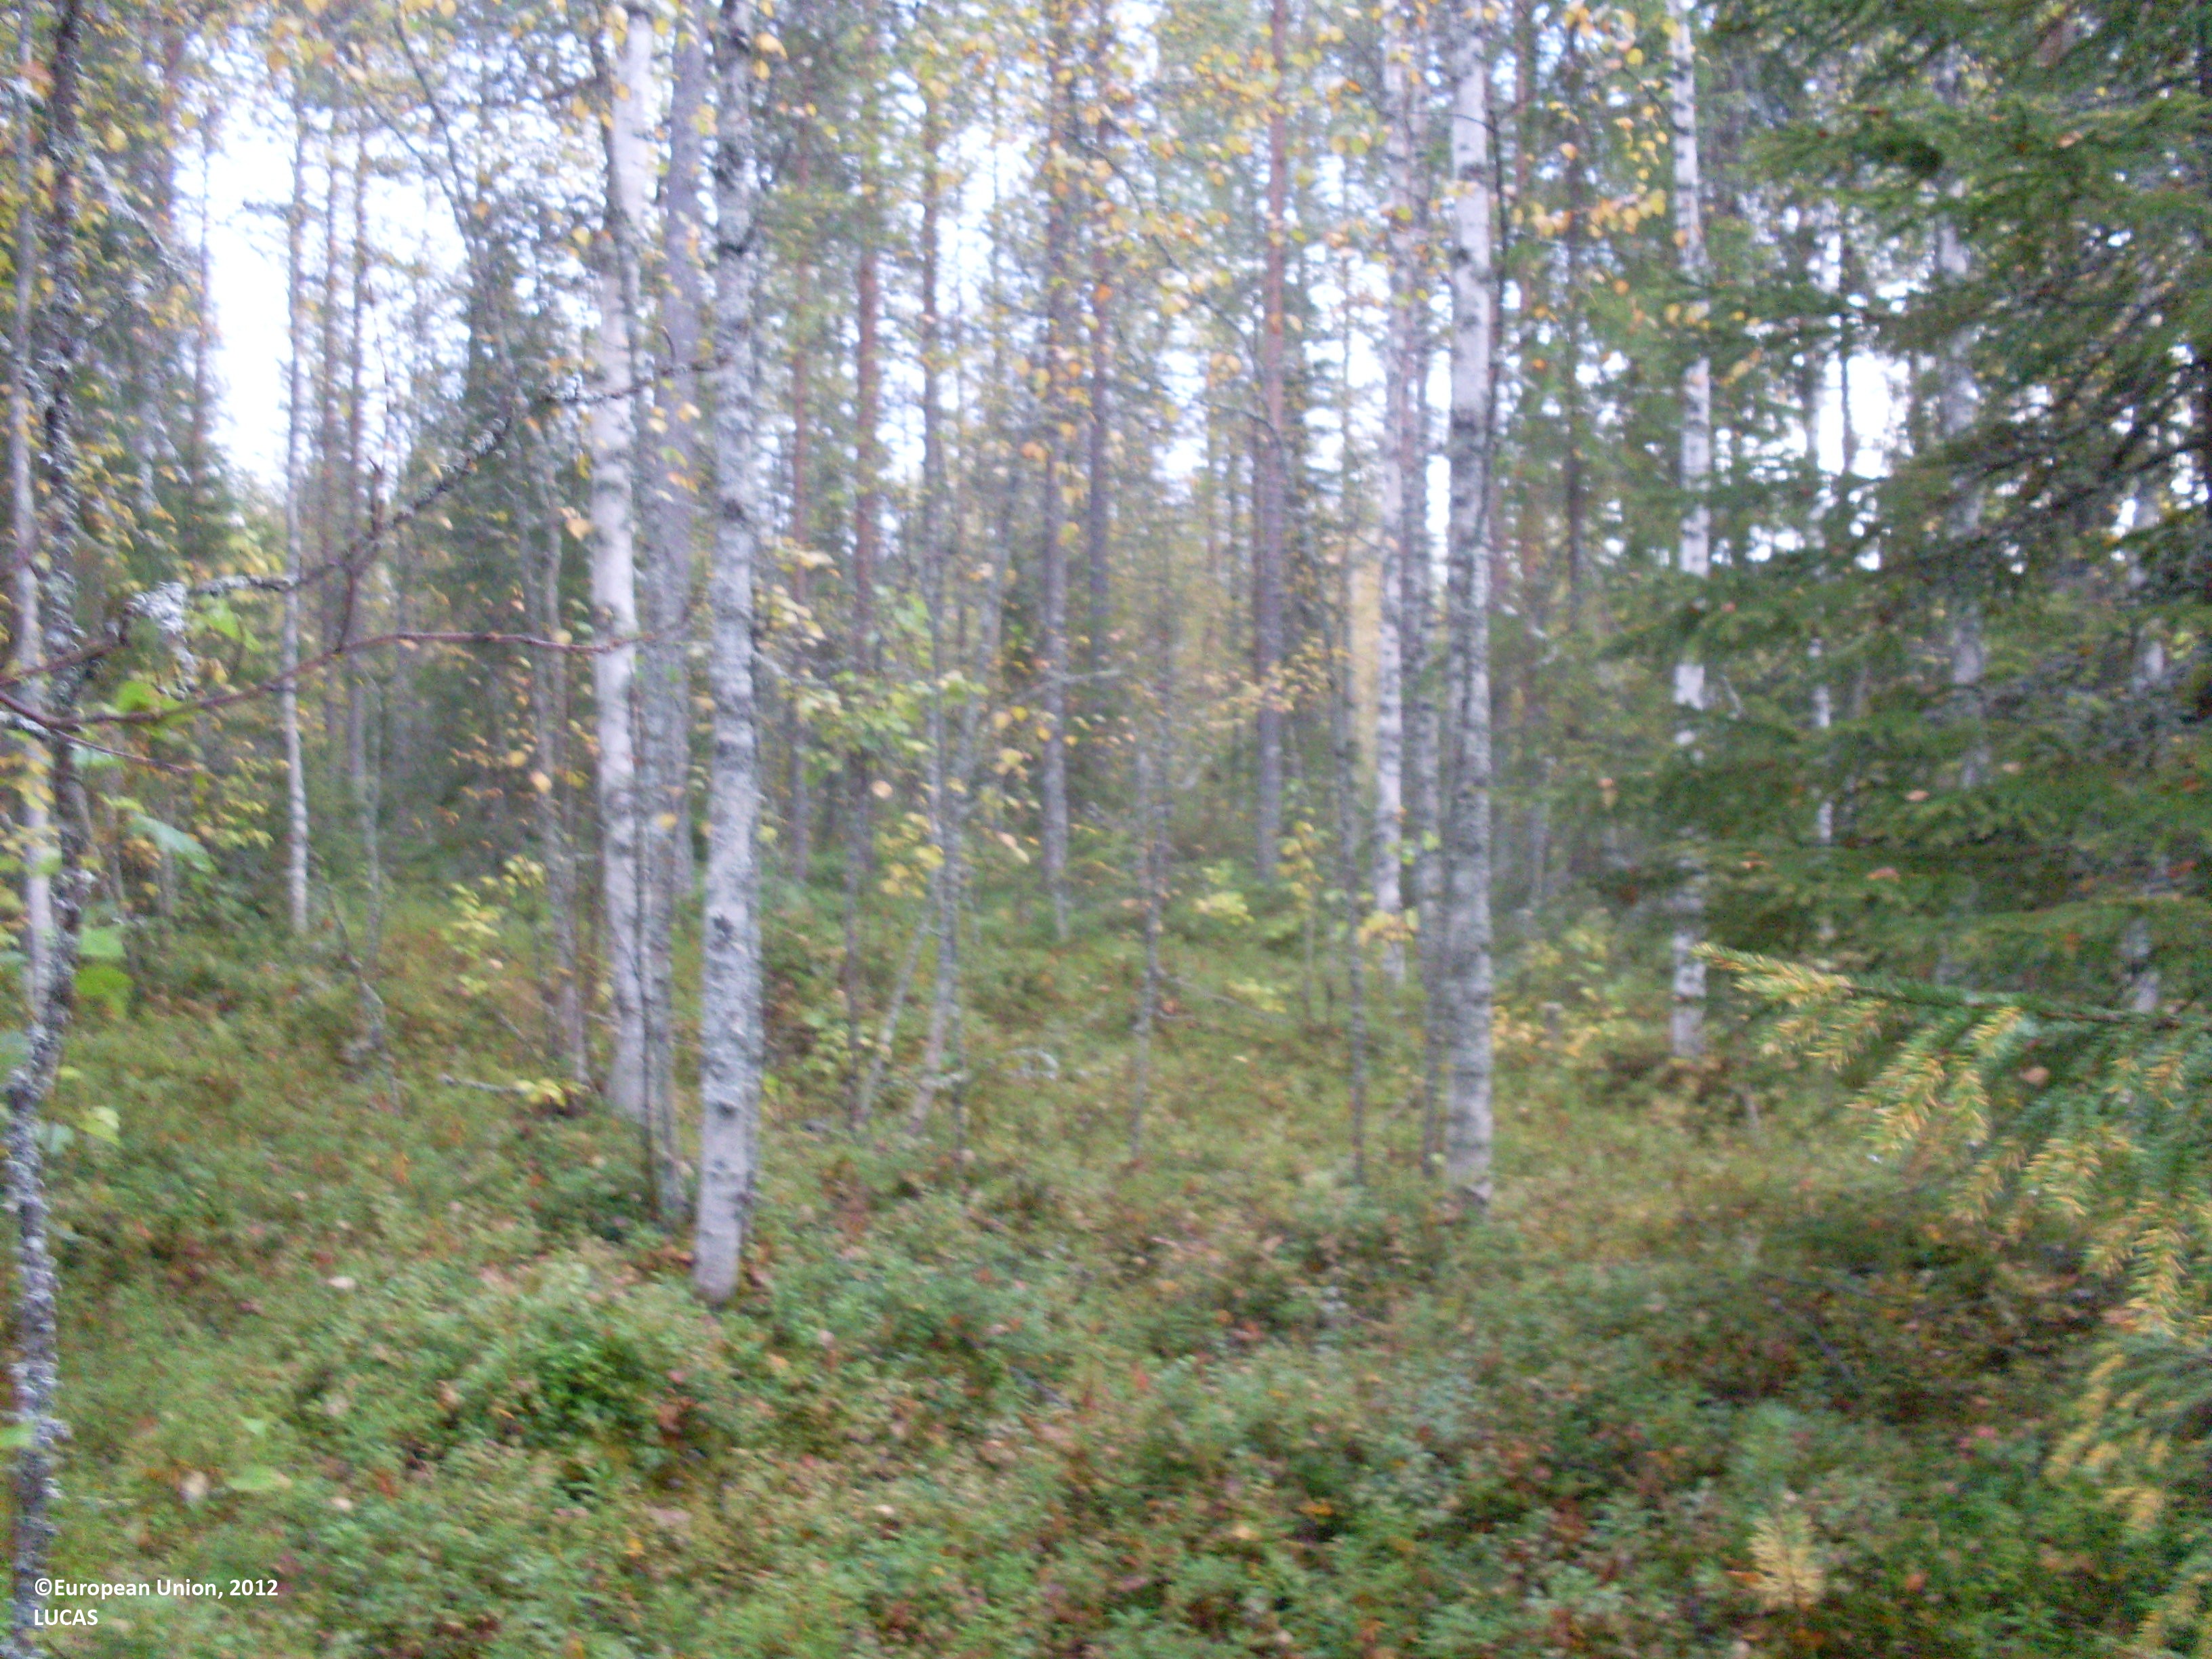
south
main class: Woodland
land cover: Other mixed woodland
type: boreal forest
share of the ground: > 75 %
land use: Forestry
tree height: > 5 m
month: September
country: FI
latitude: 64.0336
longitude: 29.9088
